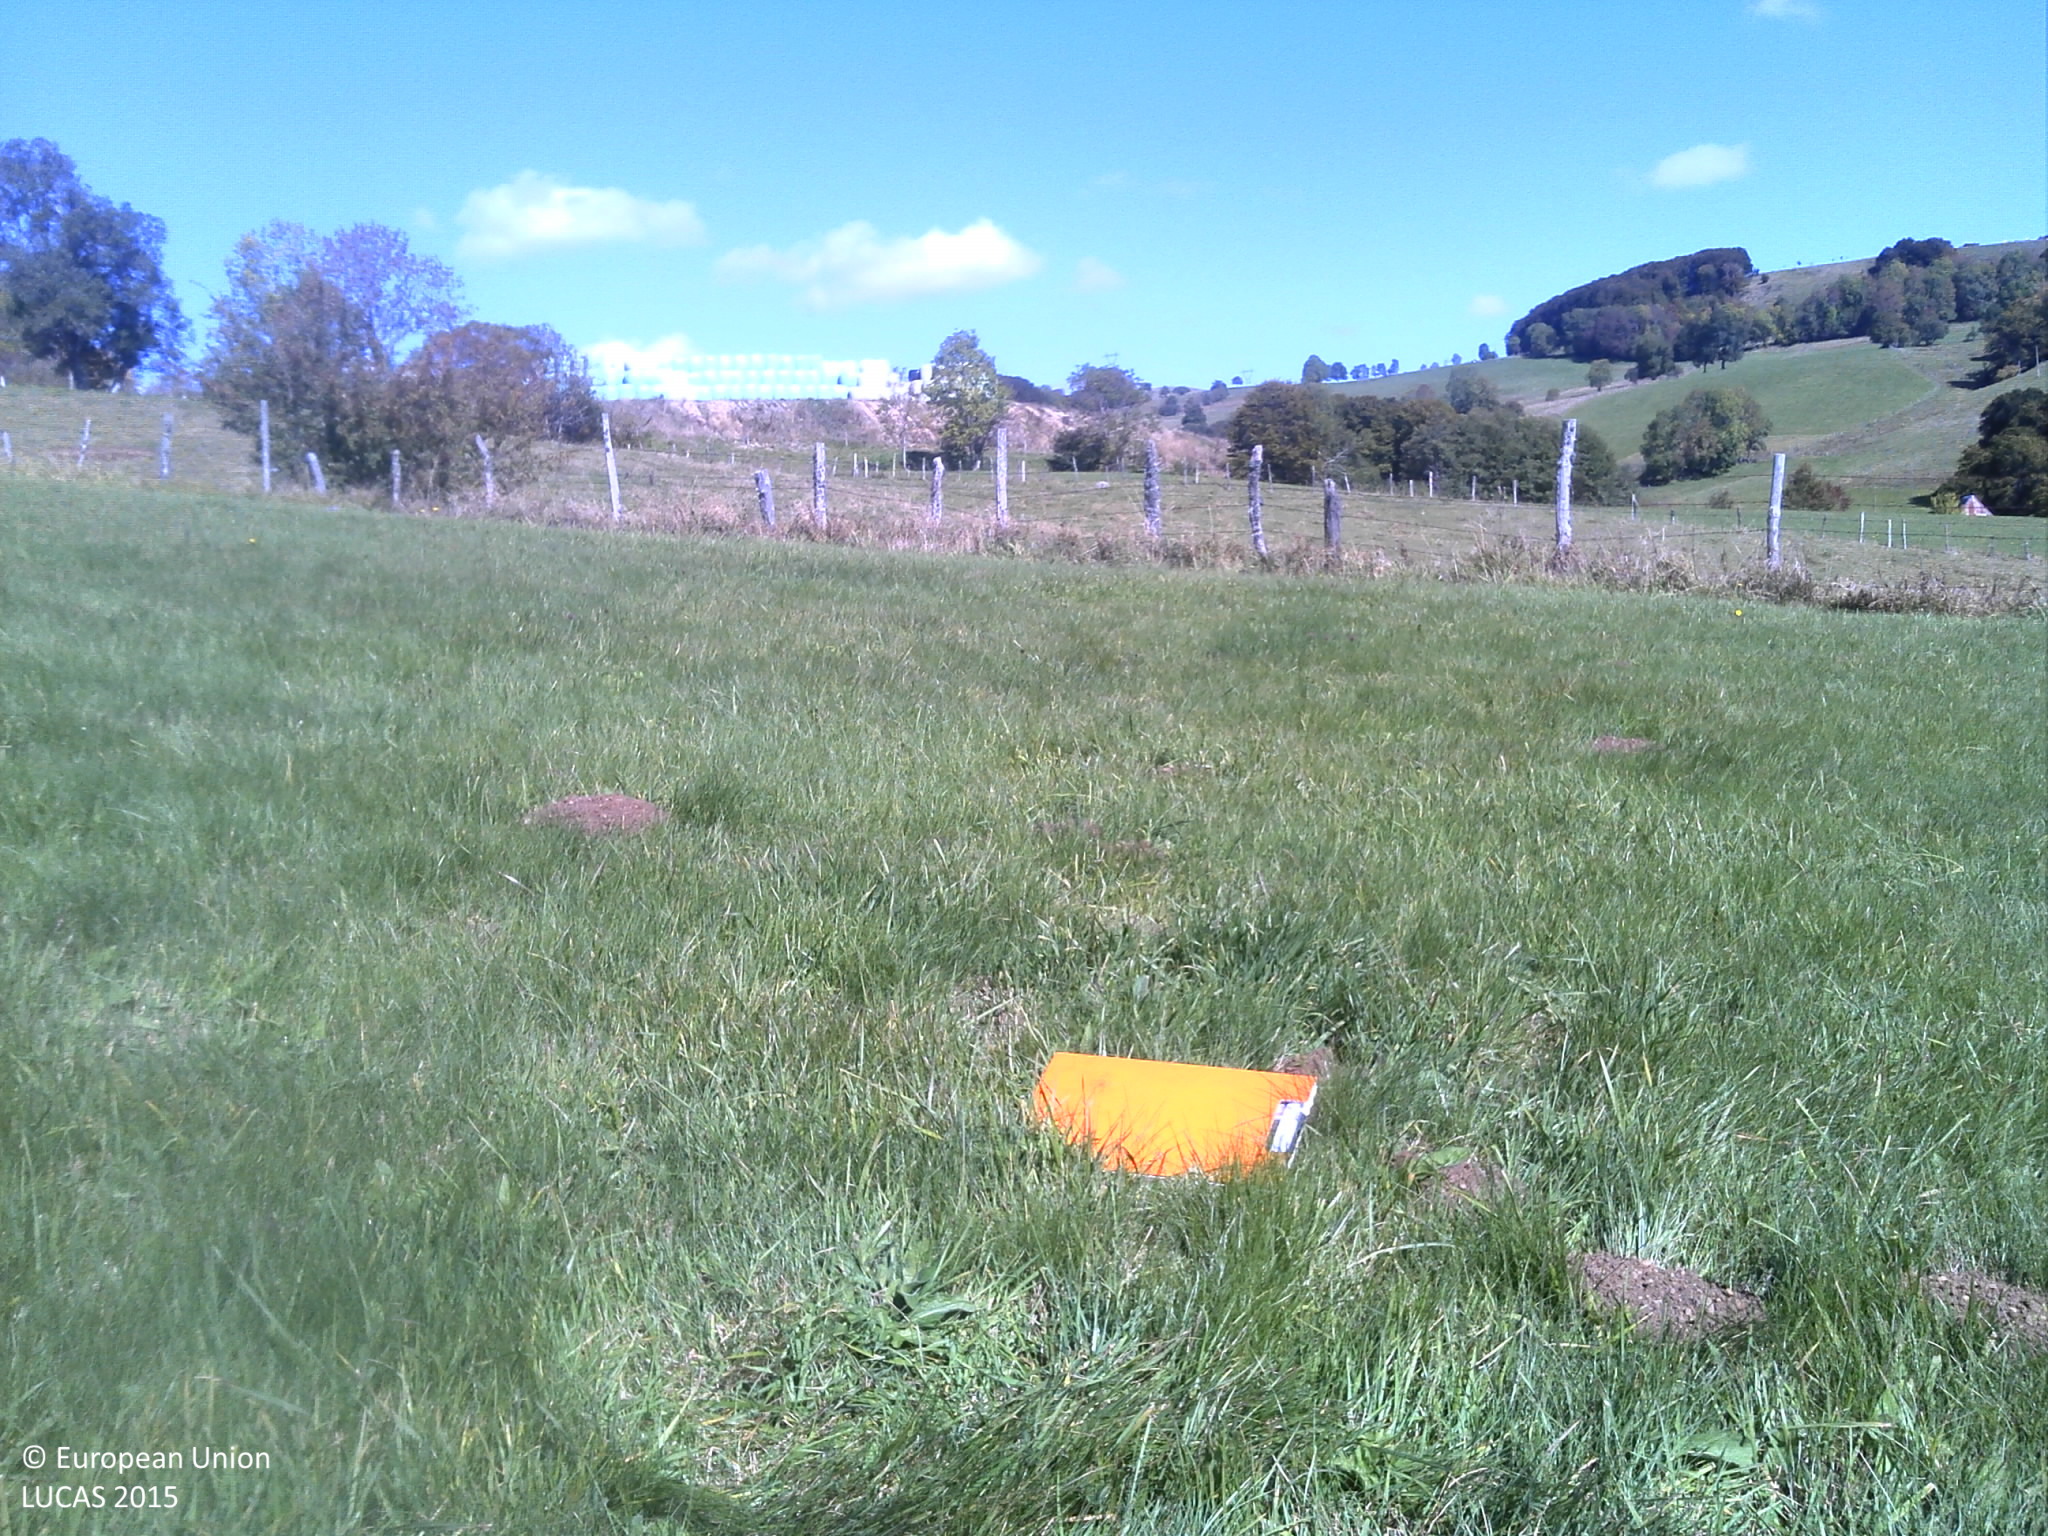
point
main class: Grassland
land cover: Grassland without tree/shrub cover
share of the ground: > 75 %
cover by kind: herbaceous plants 100 %
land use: Agriculture (excluding fallow land and kitchen gardens)
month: September
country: FR
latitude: 45.4250
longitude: 2.8557
